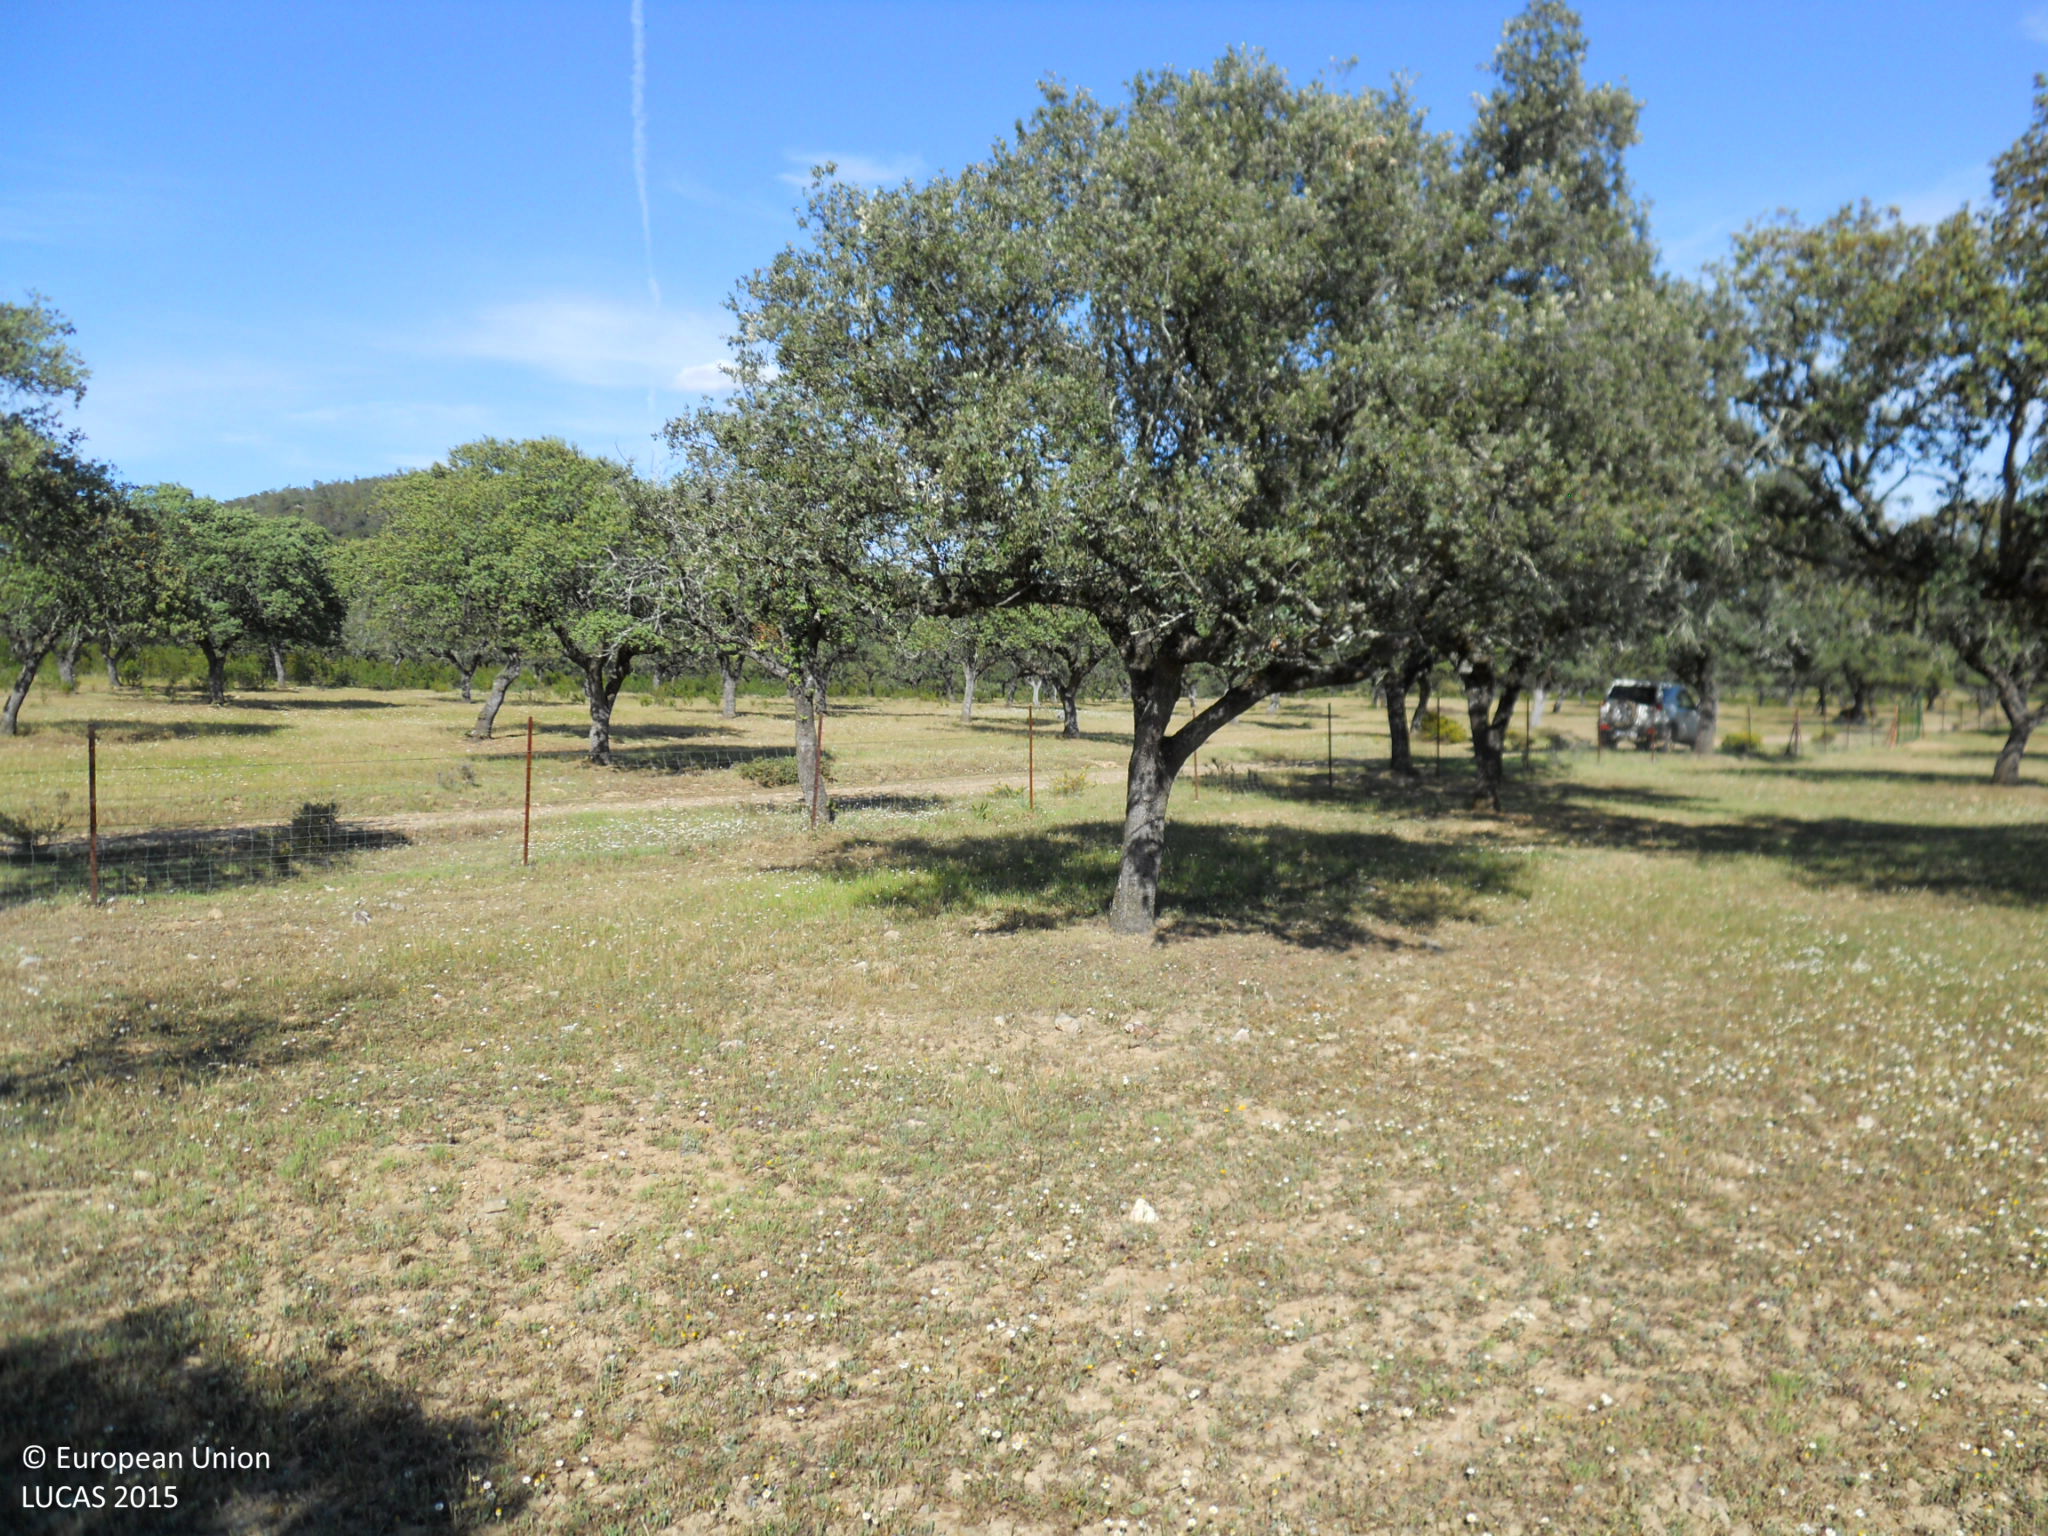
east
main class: Woodland
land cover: Broadleaved woodland
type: broadleaved evergreen forest
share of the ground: 25 - 50 %
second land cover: Grassland without tree/shrub cover
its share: > 75 %
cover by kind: herbaceous plants 65 %, broadleaved forest trees 35 %
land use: Forestry
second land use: Agriculture (excluding fallow land and kitchen gardens)
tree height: > 5 m
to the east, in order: Broadleaved woodland; Grassland without tree/shrub cover; Fences; Tracks; Broadleaved woodland; Tracks; Broadleaved woodland; Artificial constructions
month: April
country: ES
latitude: 39.3579
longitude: -6.9167
